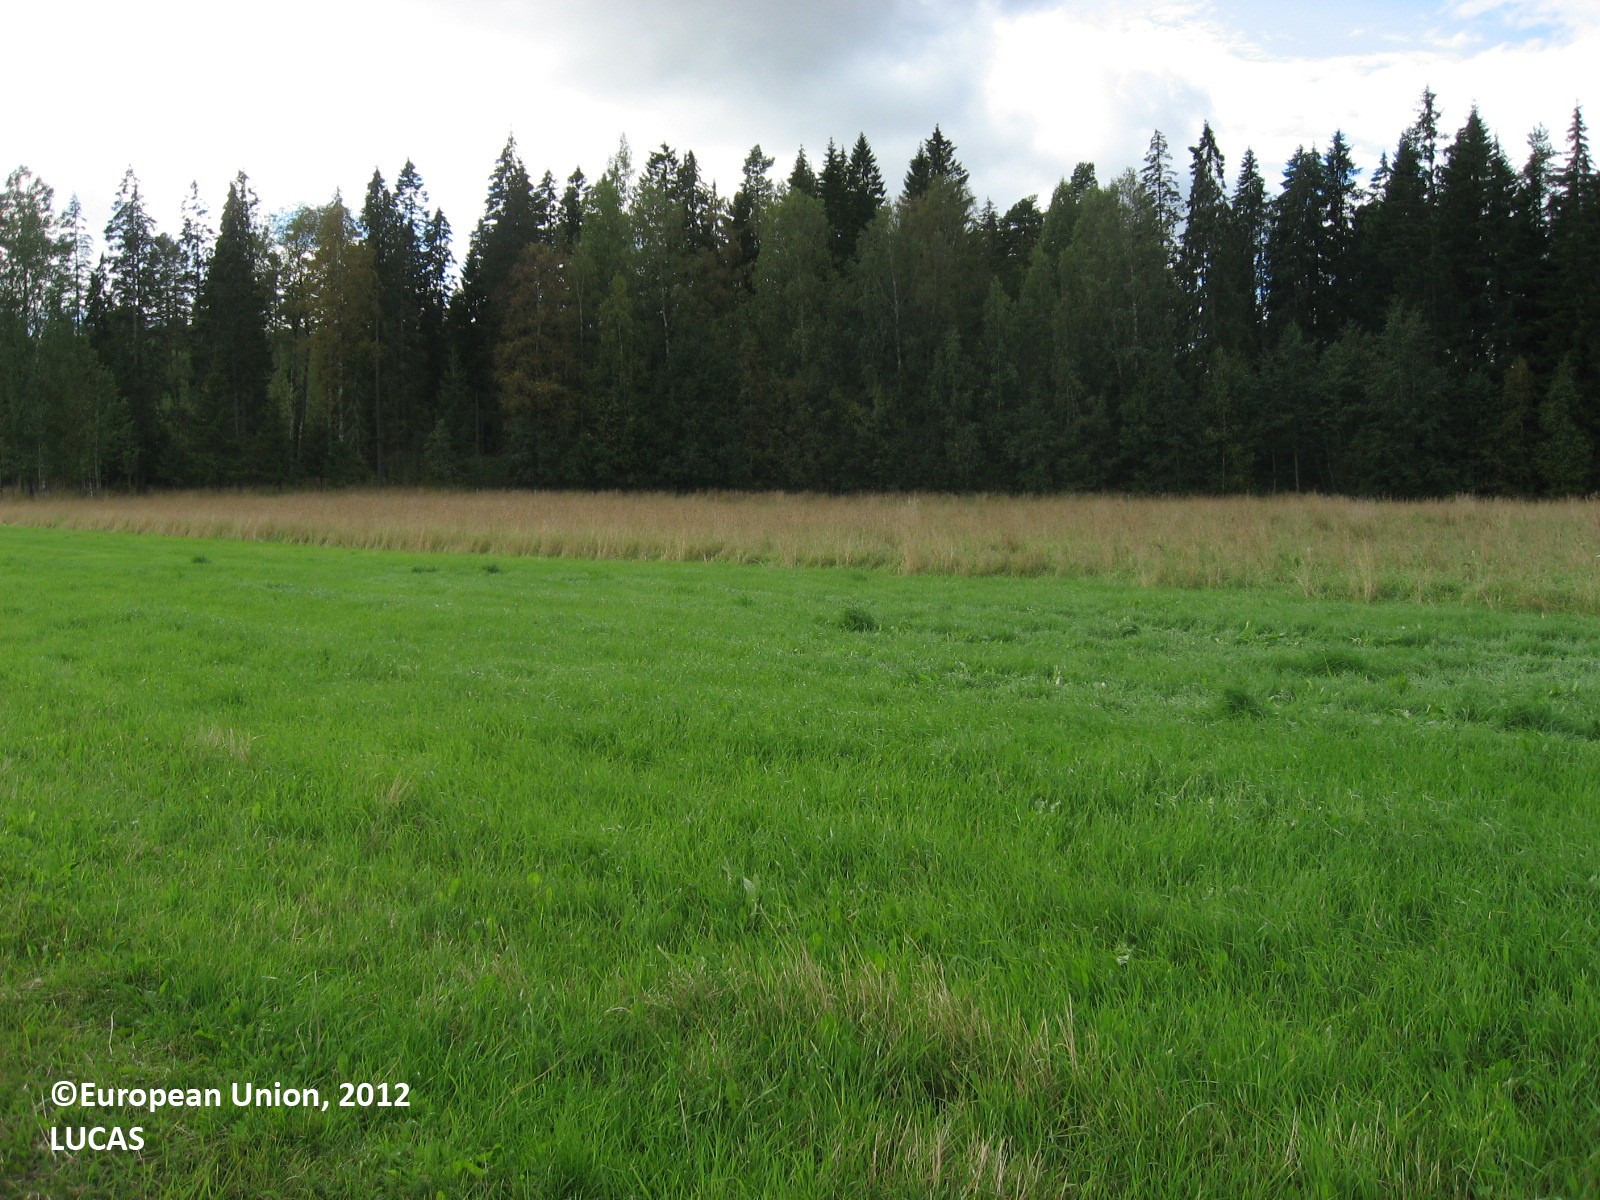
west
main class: Cropland
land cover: Temporary grasslands
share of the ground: > 75 %
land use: Agriculture (excluding fallow land and kitchen gardens)
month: September
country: FI
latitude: 60.9147
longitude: 25.1852
